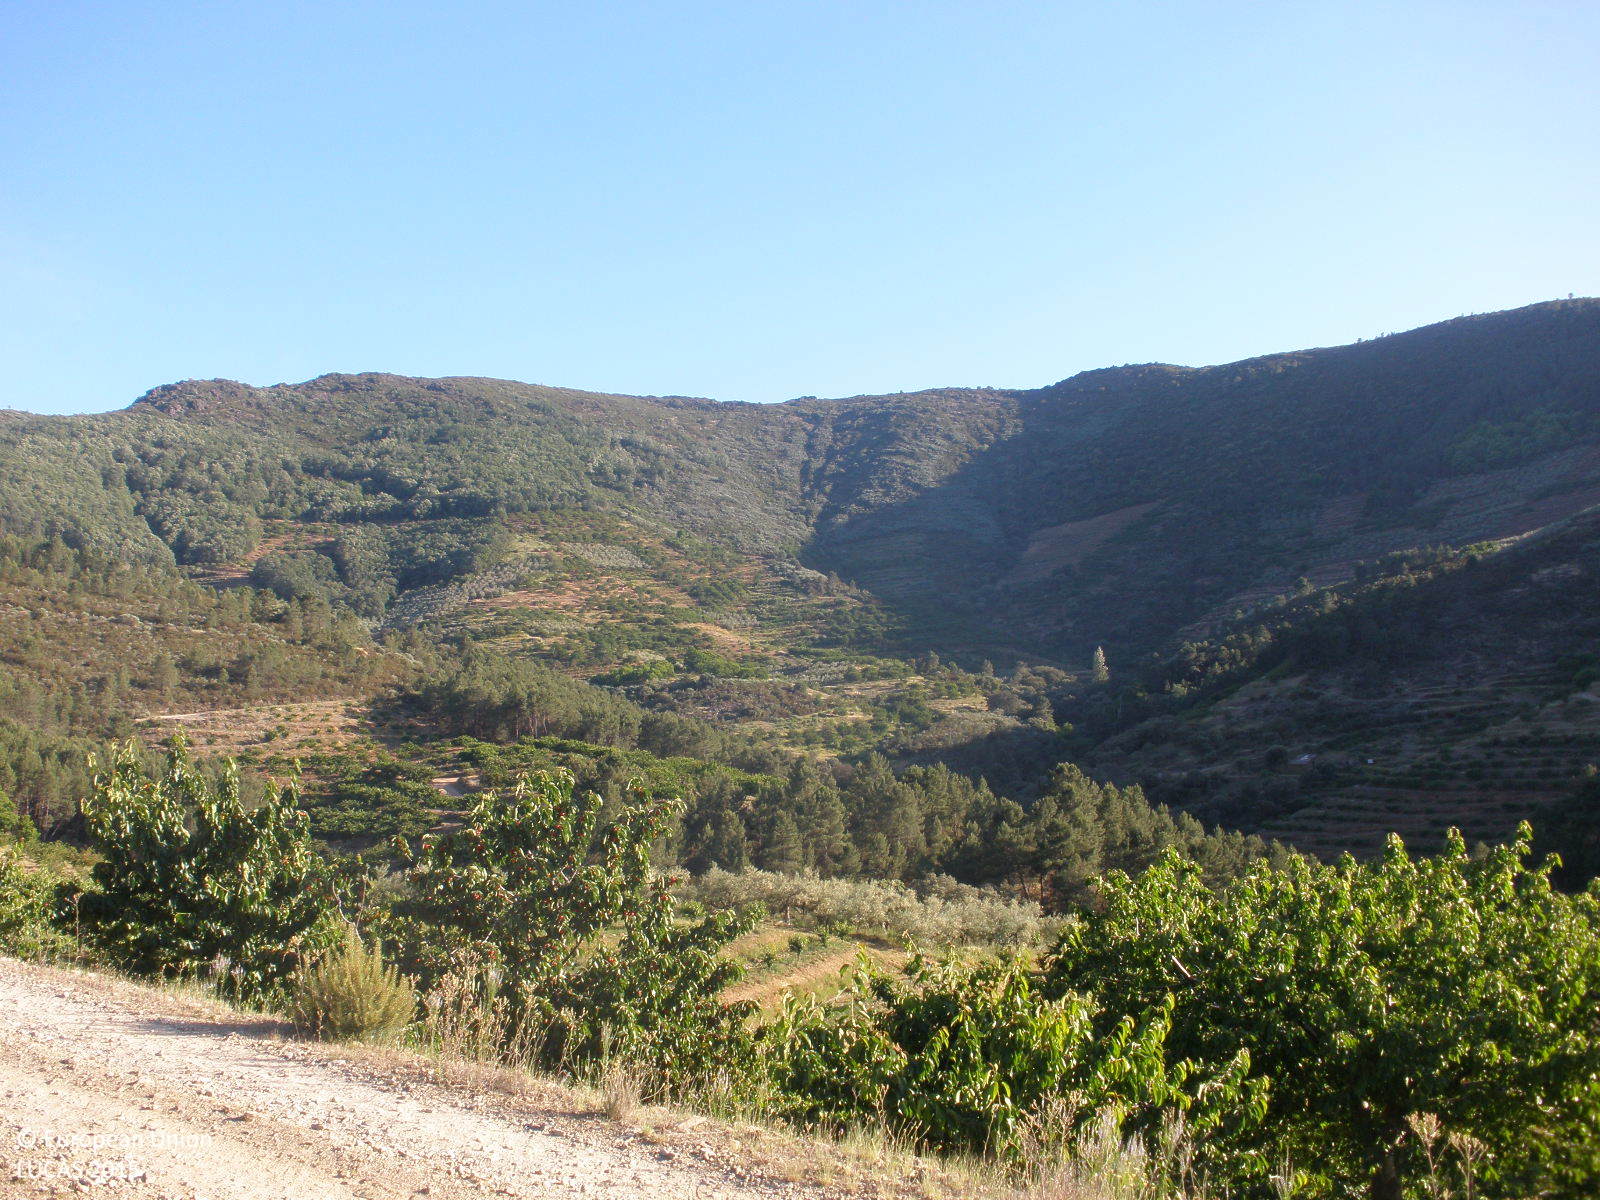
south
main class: Cropland
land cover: Cherry fruit
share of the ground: 10 - 25 %
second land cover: Spontaneously vegetated surfaces
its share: 10 - 25 %
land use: Agriculture (excluding fallow land and kitchen gardens)
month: May
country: ES
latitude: 40.2927
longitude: -6.3021
